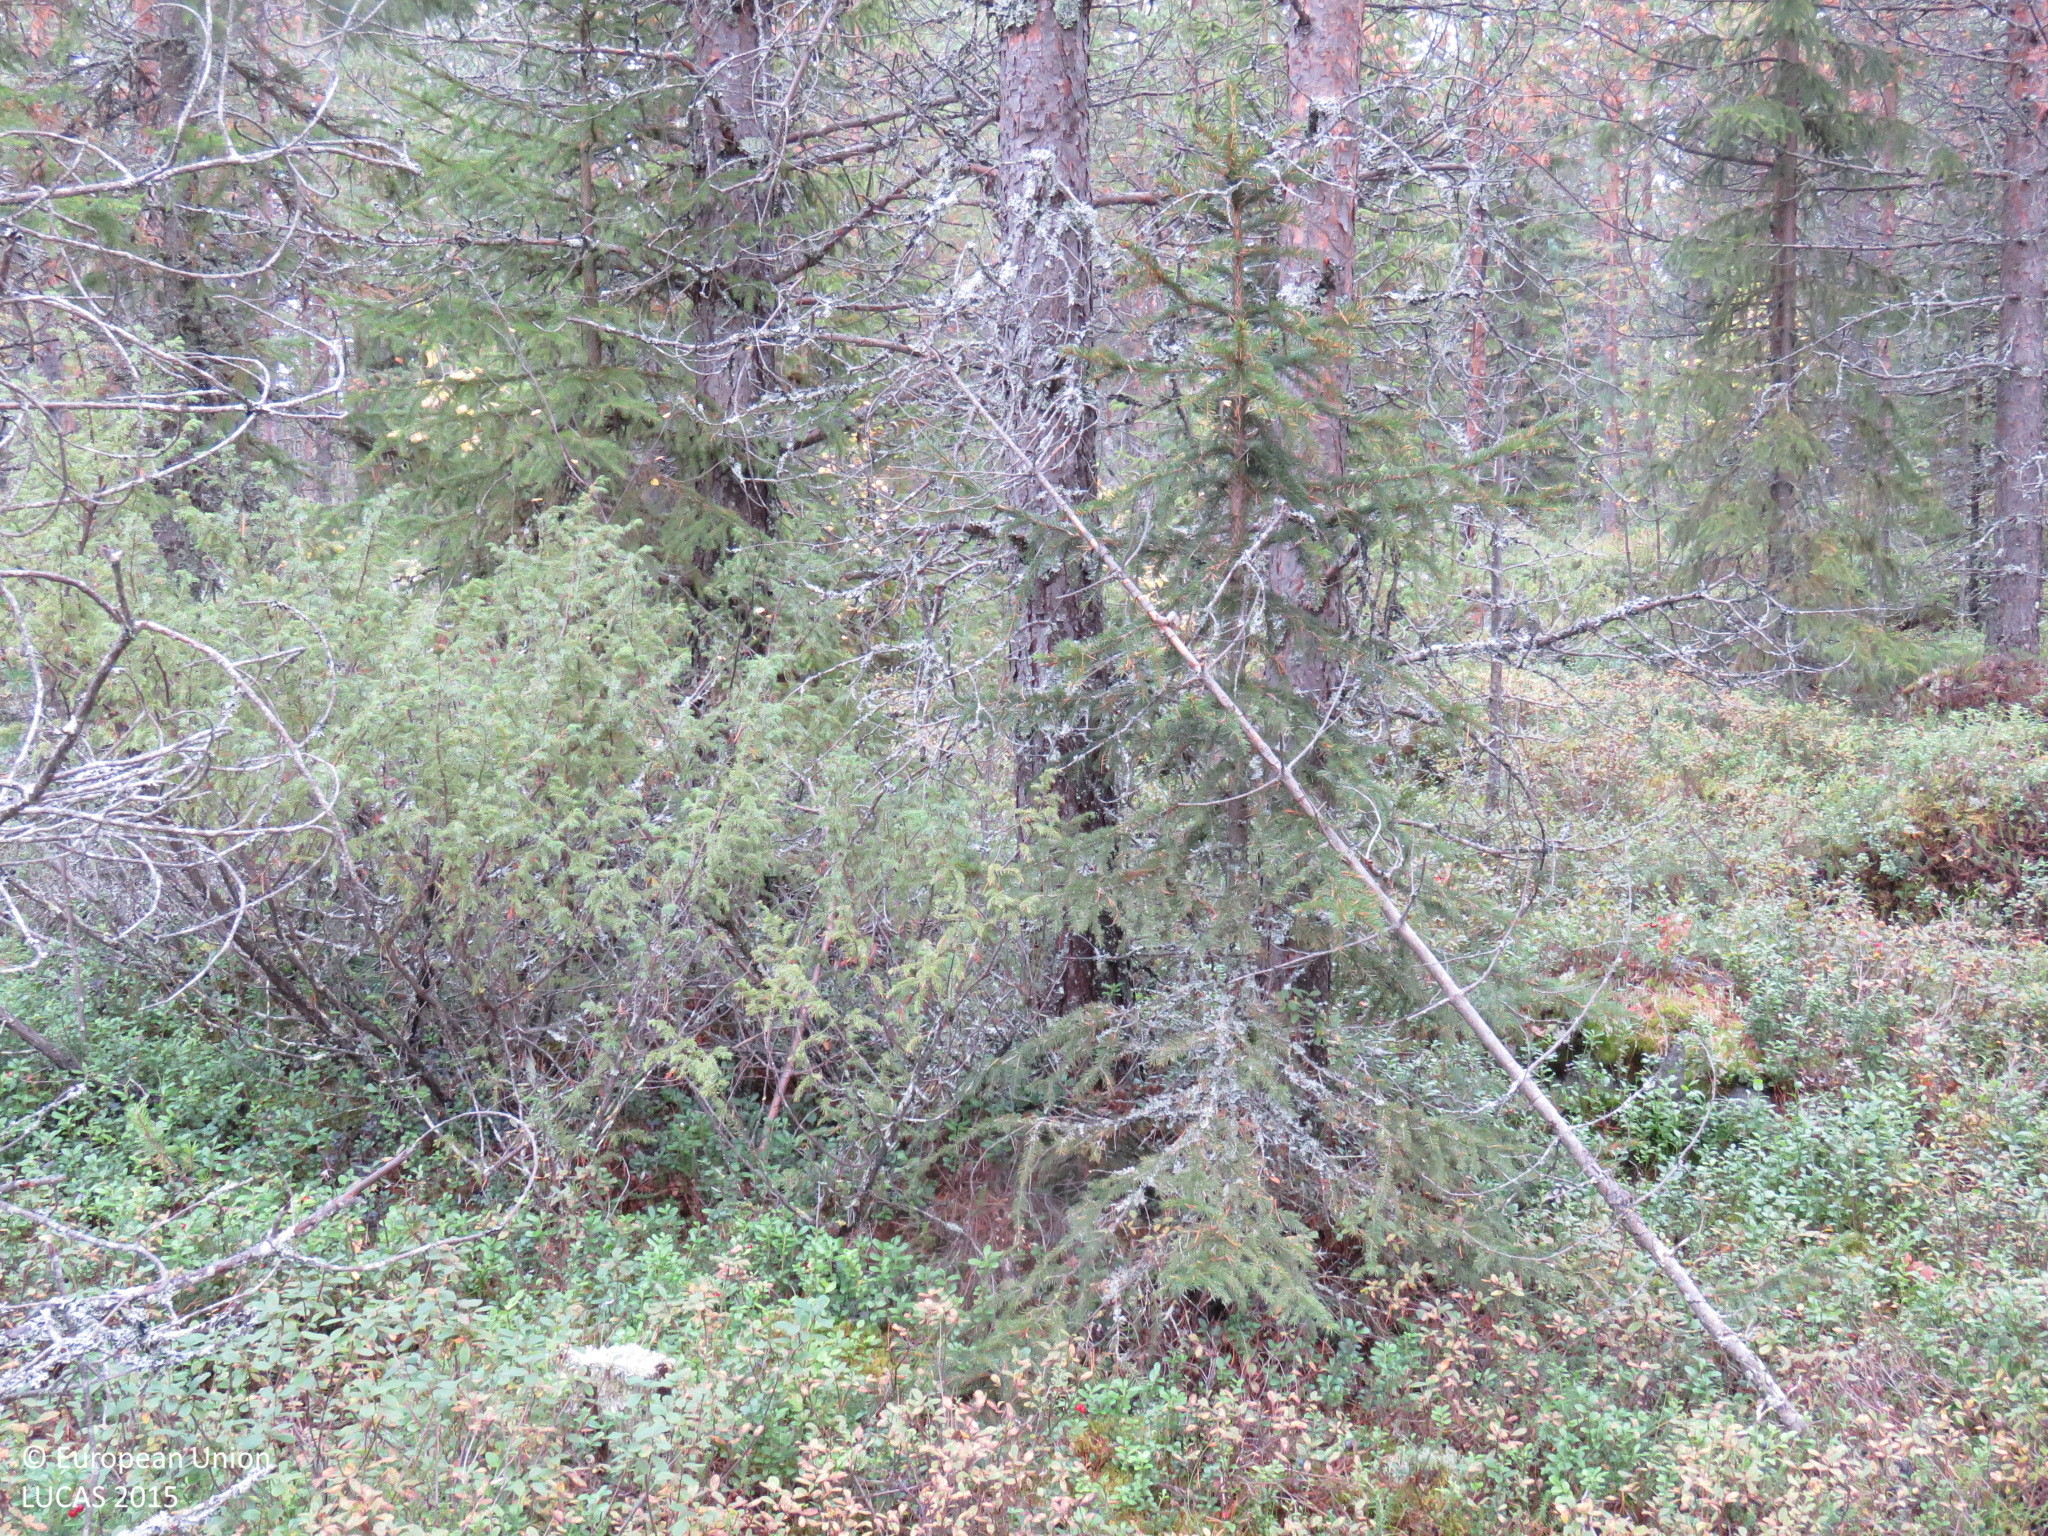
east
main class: Woodland
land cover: Other coniferous woodland
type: boreal forest
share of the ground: > 75 %
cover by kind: coniferous forest trees 75 %, shrubs 15 %, broadleaved forest trees 5 %, lichens and mosses 5 %
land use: Forestry
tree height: > 5 m
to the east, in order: Other coniferous woodland; Shrubland with sparse tree cover; Pine dominated coniferous woodland
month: September
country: FI
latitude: 65.2266
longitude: 27.4340
